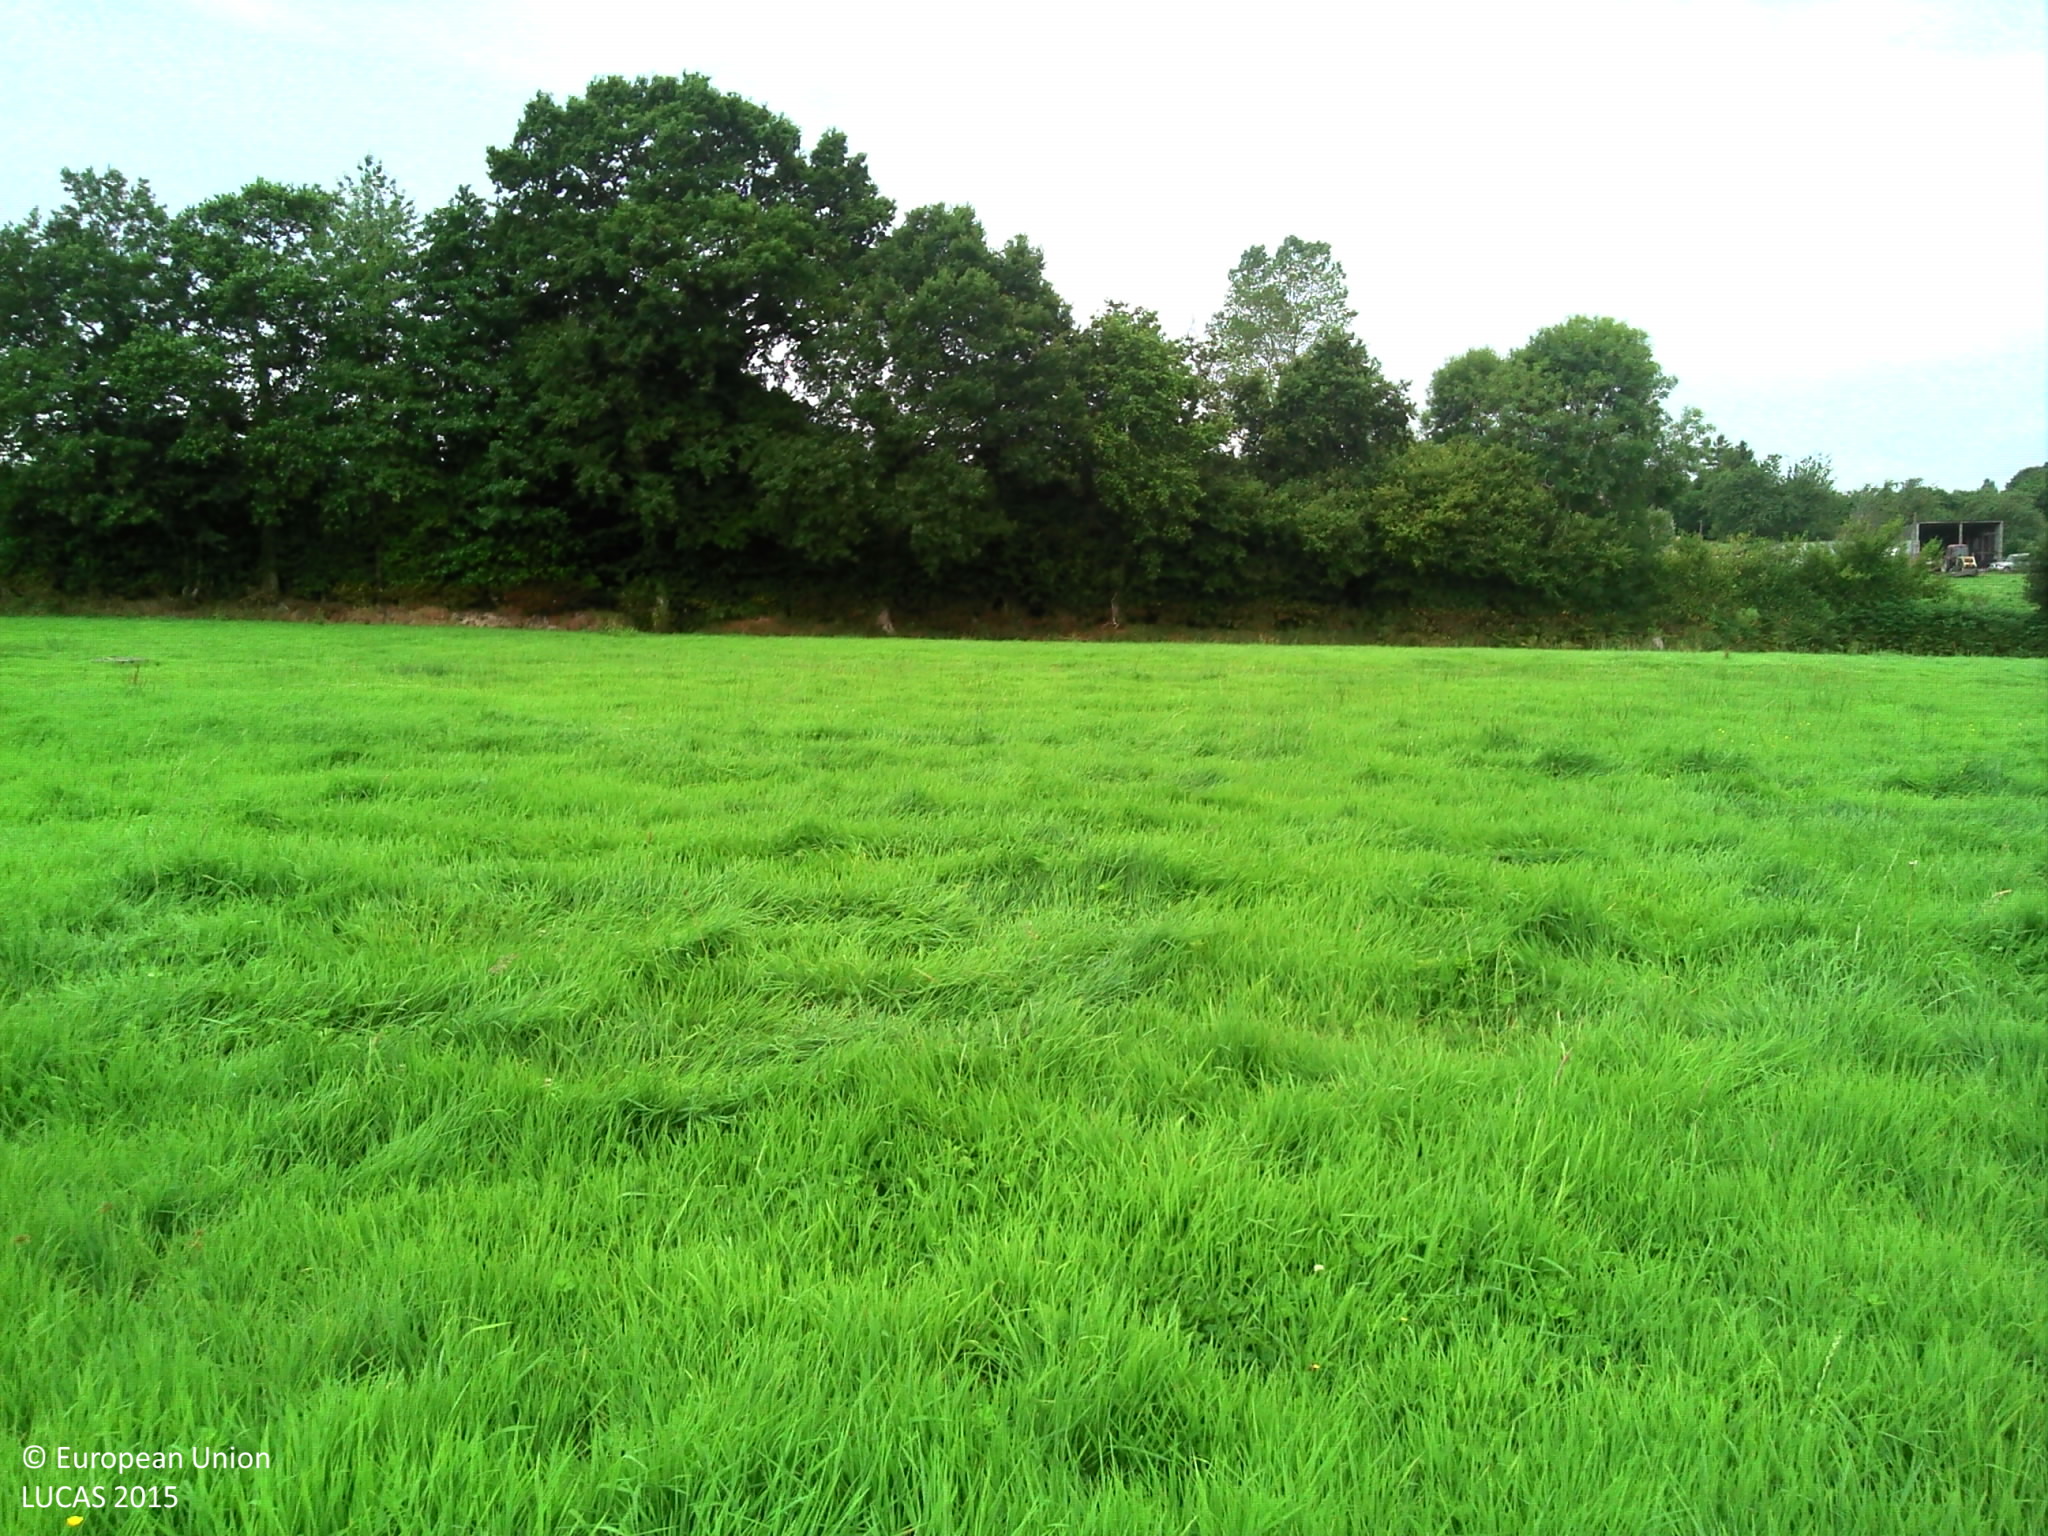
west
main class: Grassland
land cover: Grassland without tree/shrub cover
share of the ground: > 75 %
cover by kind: herbaceous plants 100 %
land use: Agriculture (excluding fallow land and kitchen gardens)
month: July
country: FR
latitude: 48.8614
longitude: -1.2632
